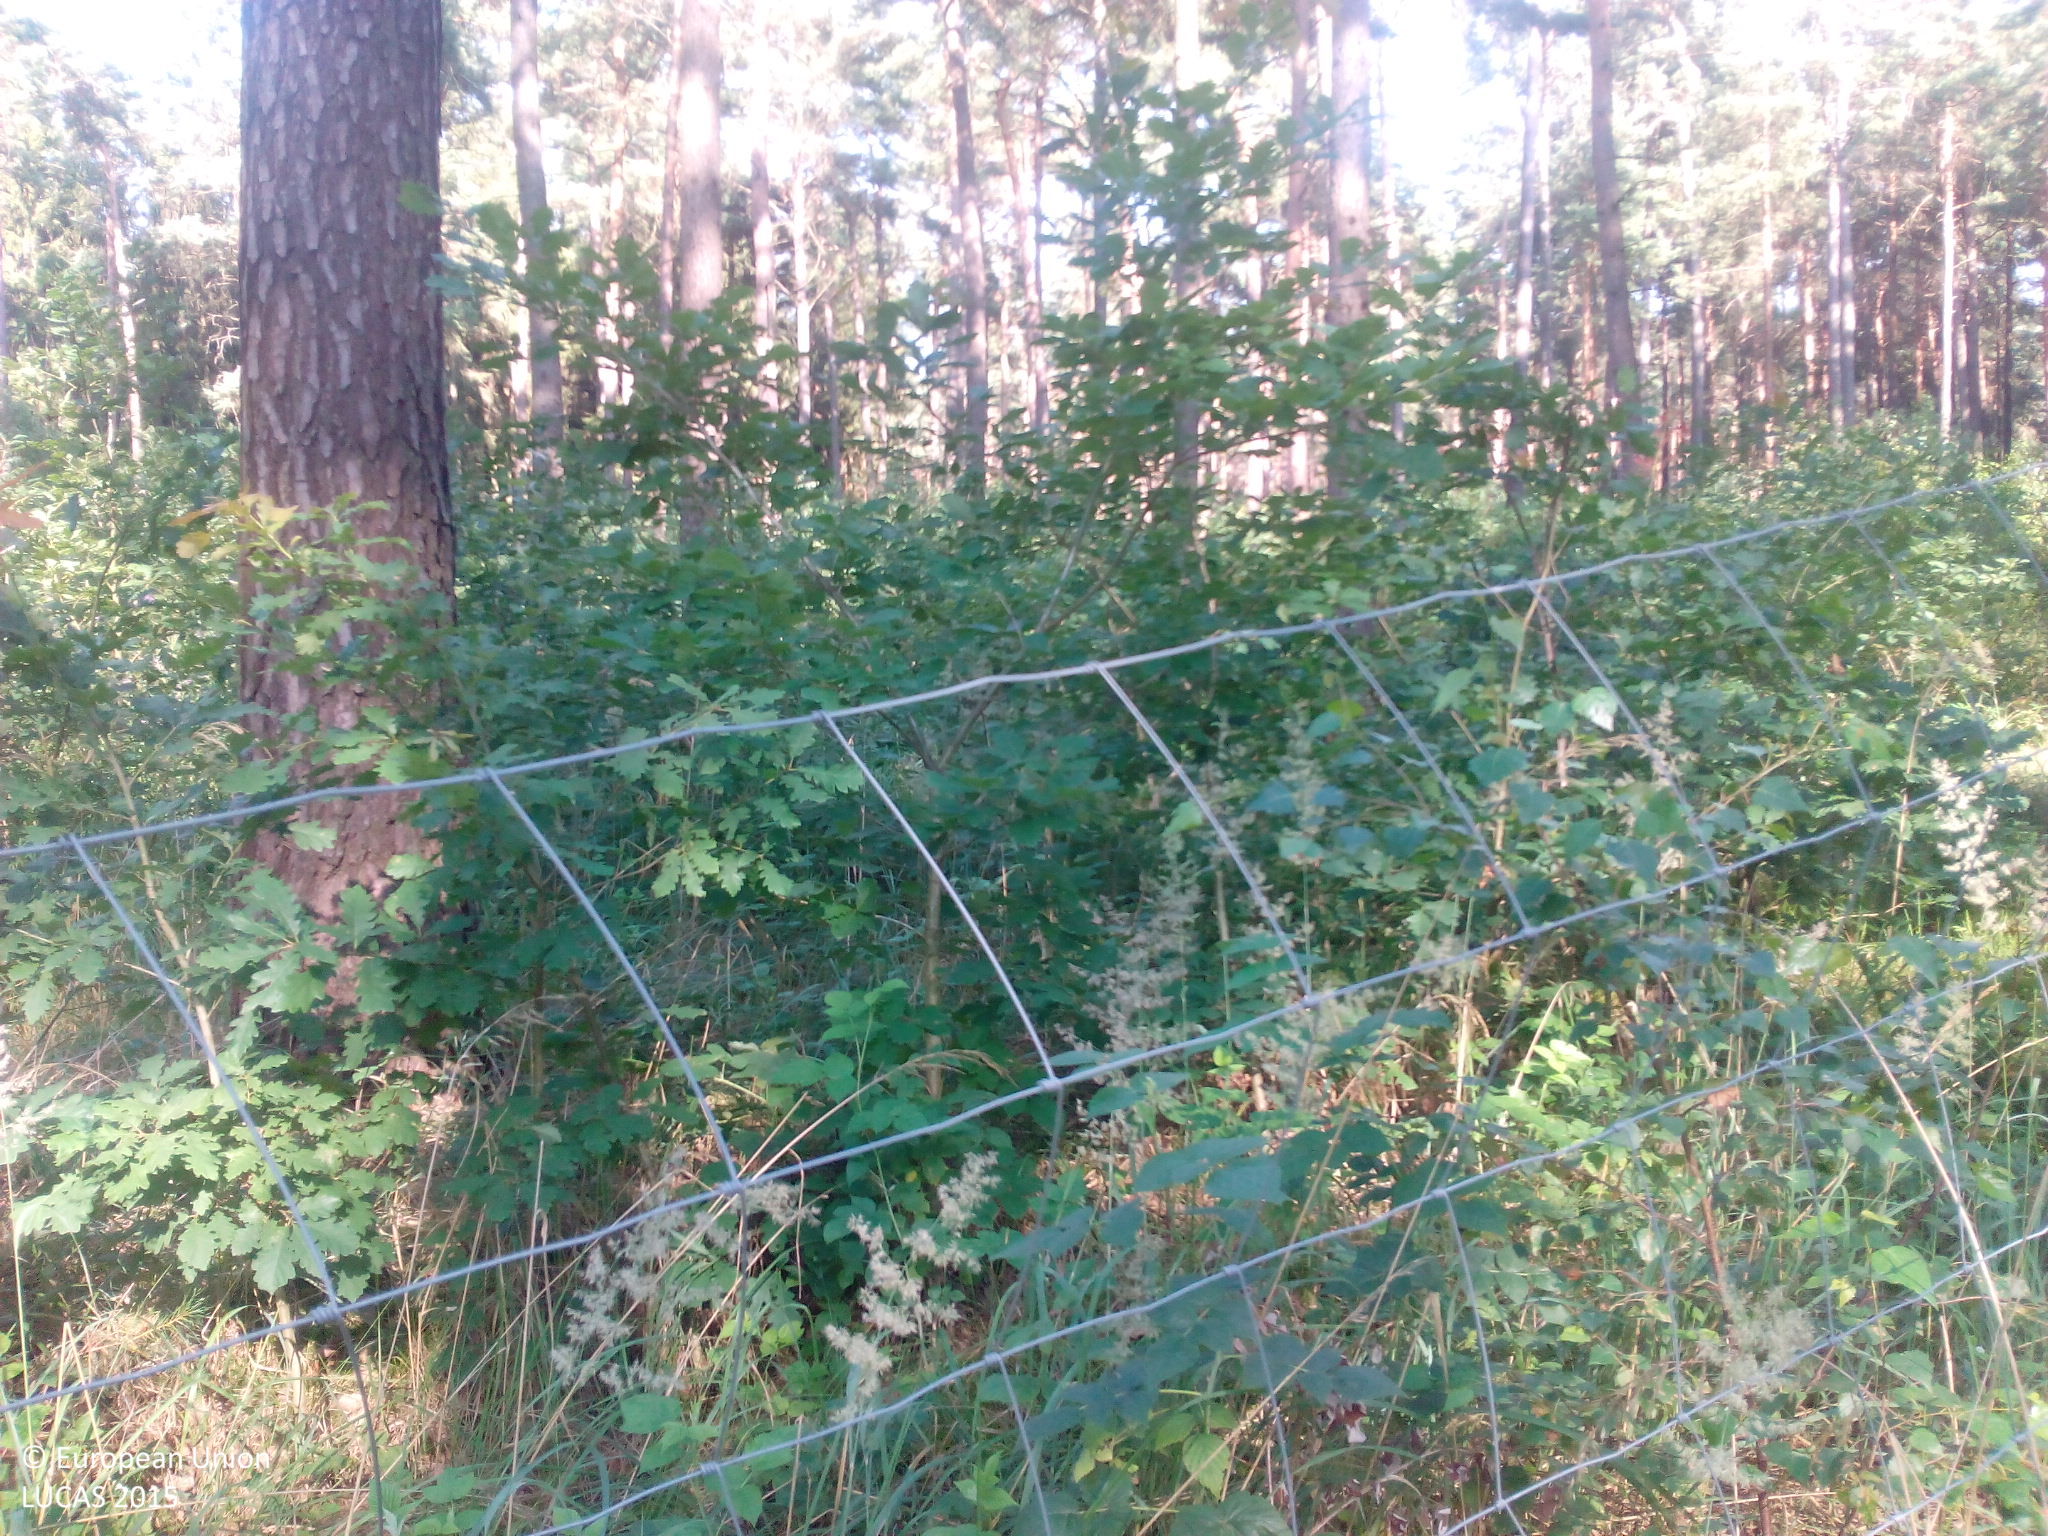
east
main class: Woodland
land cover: Pine dominated mixed woodland
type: hemiboreal forest and nemoral coniferous forest and mixed broadleaved-coniferous forest
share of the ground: > 75 %
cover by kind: coniferous forest trees 70 %, broadleaved forest trees 30 %
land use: Forestry
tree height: > 5 m
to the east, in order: Pine dominated mixed woodland; Fences; Spruce dominated mixed woodland; Pine dominated mixed woodland; Pine dominated coniferous woodland
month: July
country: DE
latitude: 51.9725
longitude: 12.5472
